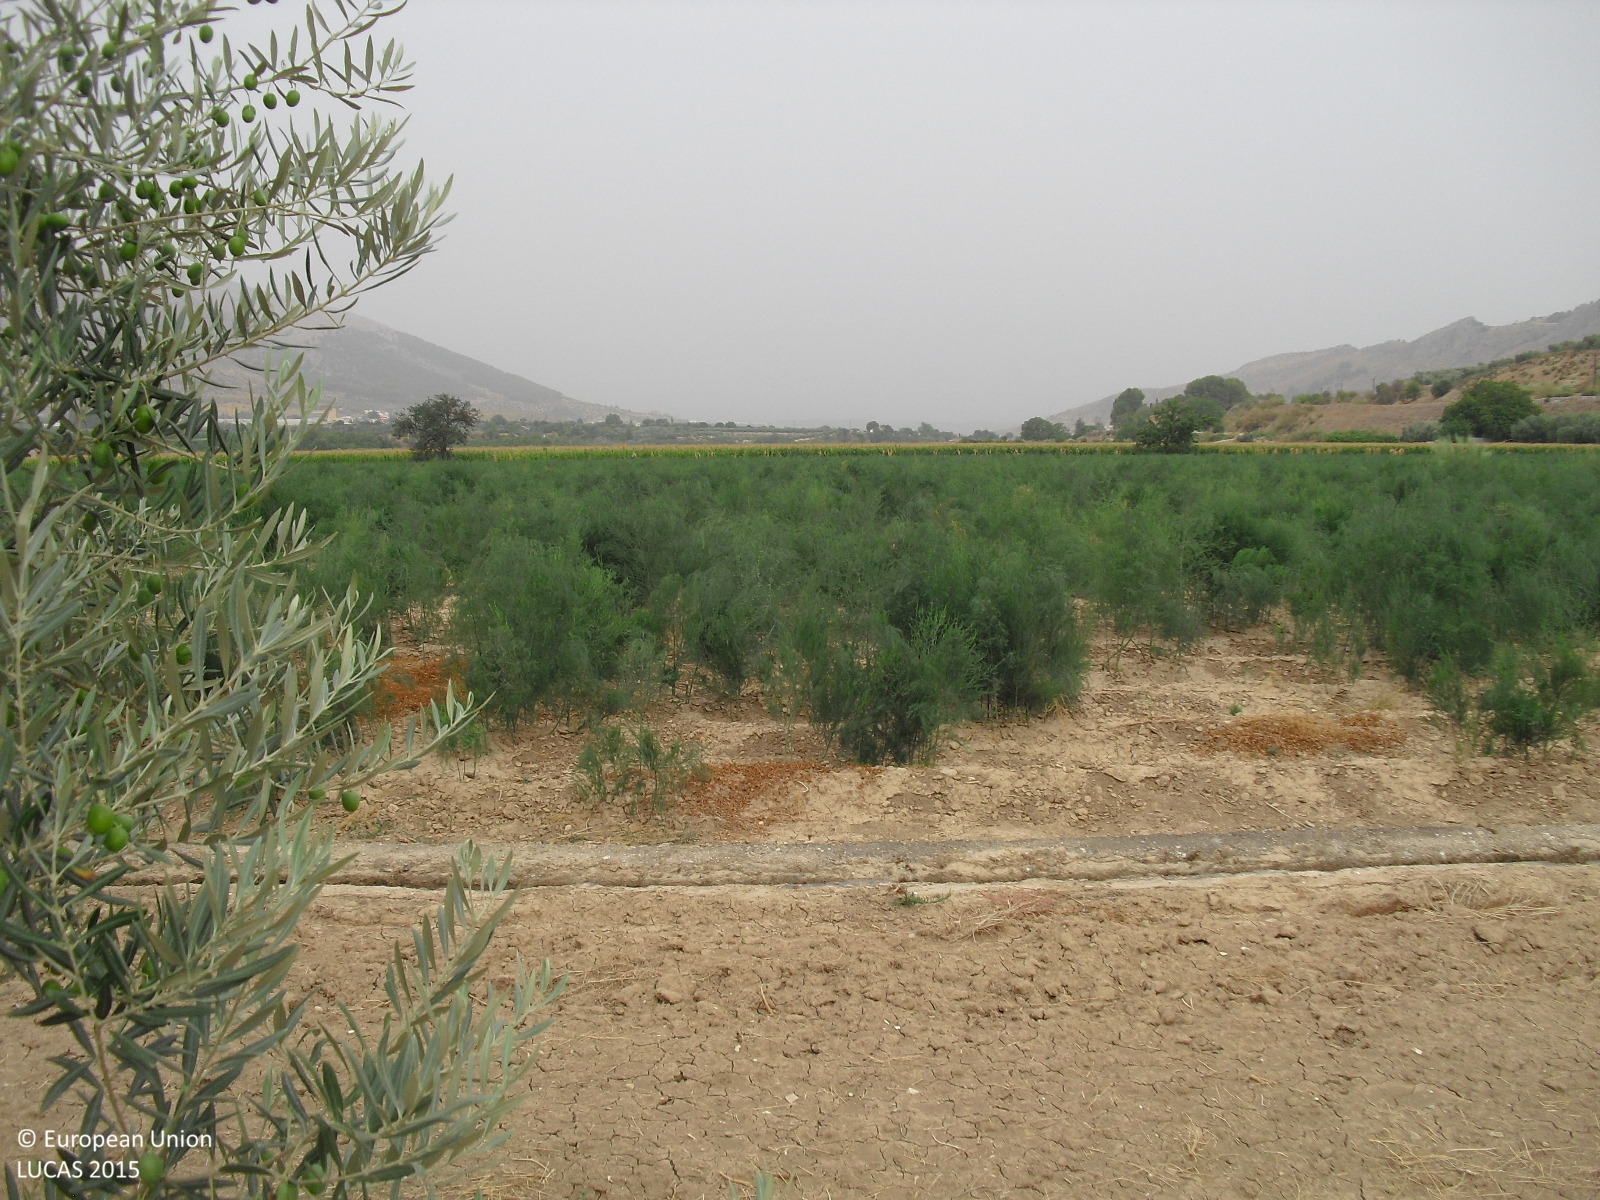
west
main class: Cropland
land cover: Olive groves
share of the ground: < 10 %
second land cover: Spontaneously vegetated surfaces
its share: 10 - 25 %
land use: Agriculture (excluding fallow land and kitchen gardens)
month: August
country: ES
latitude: 37.1683
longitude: -4.1053
